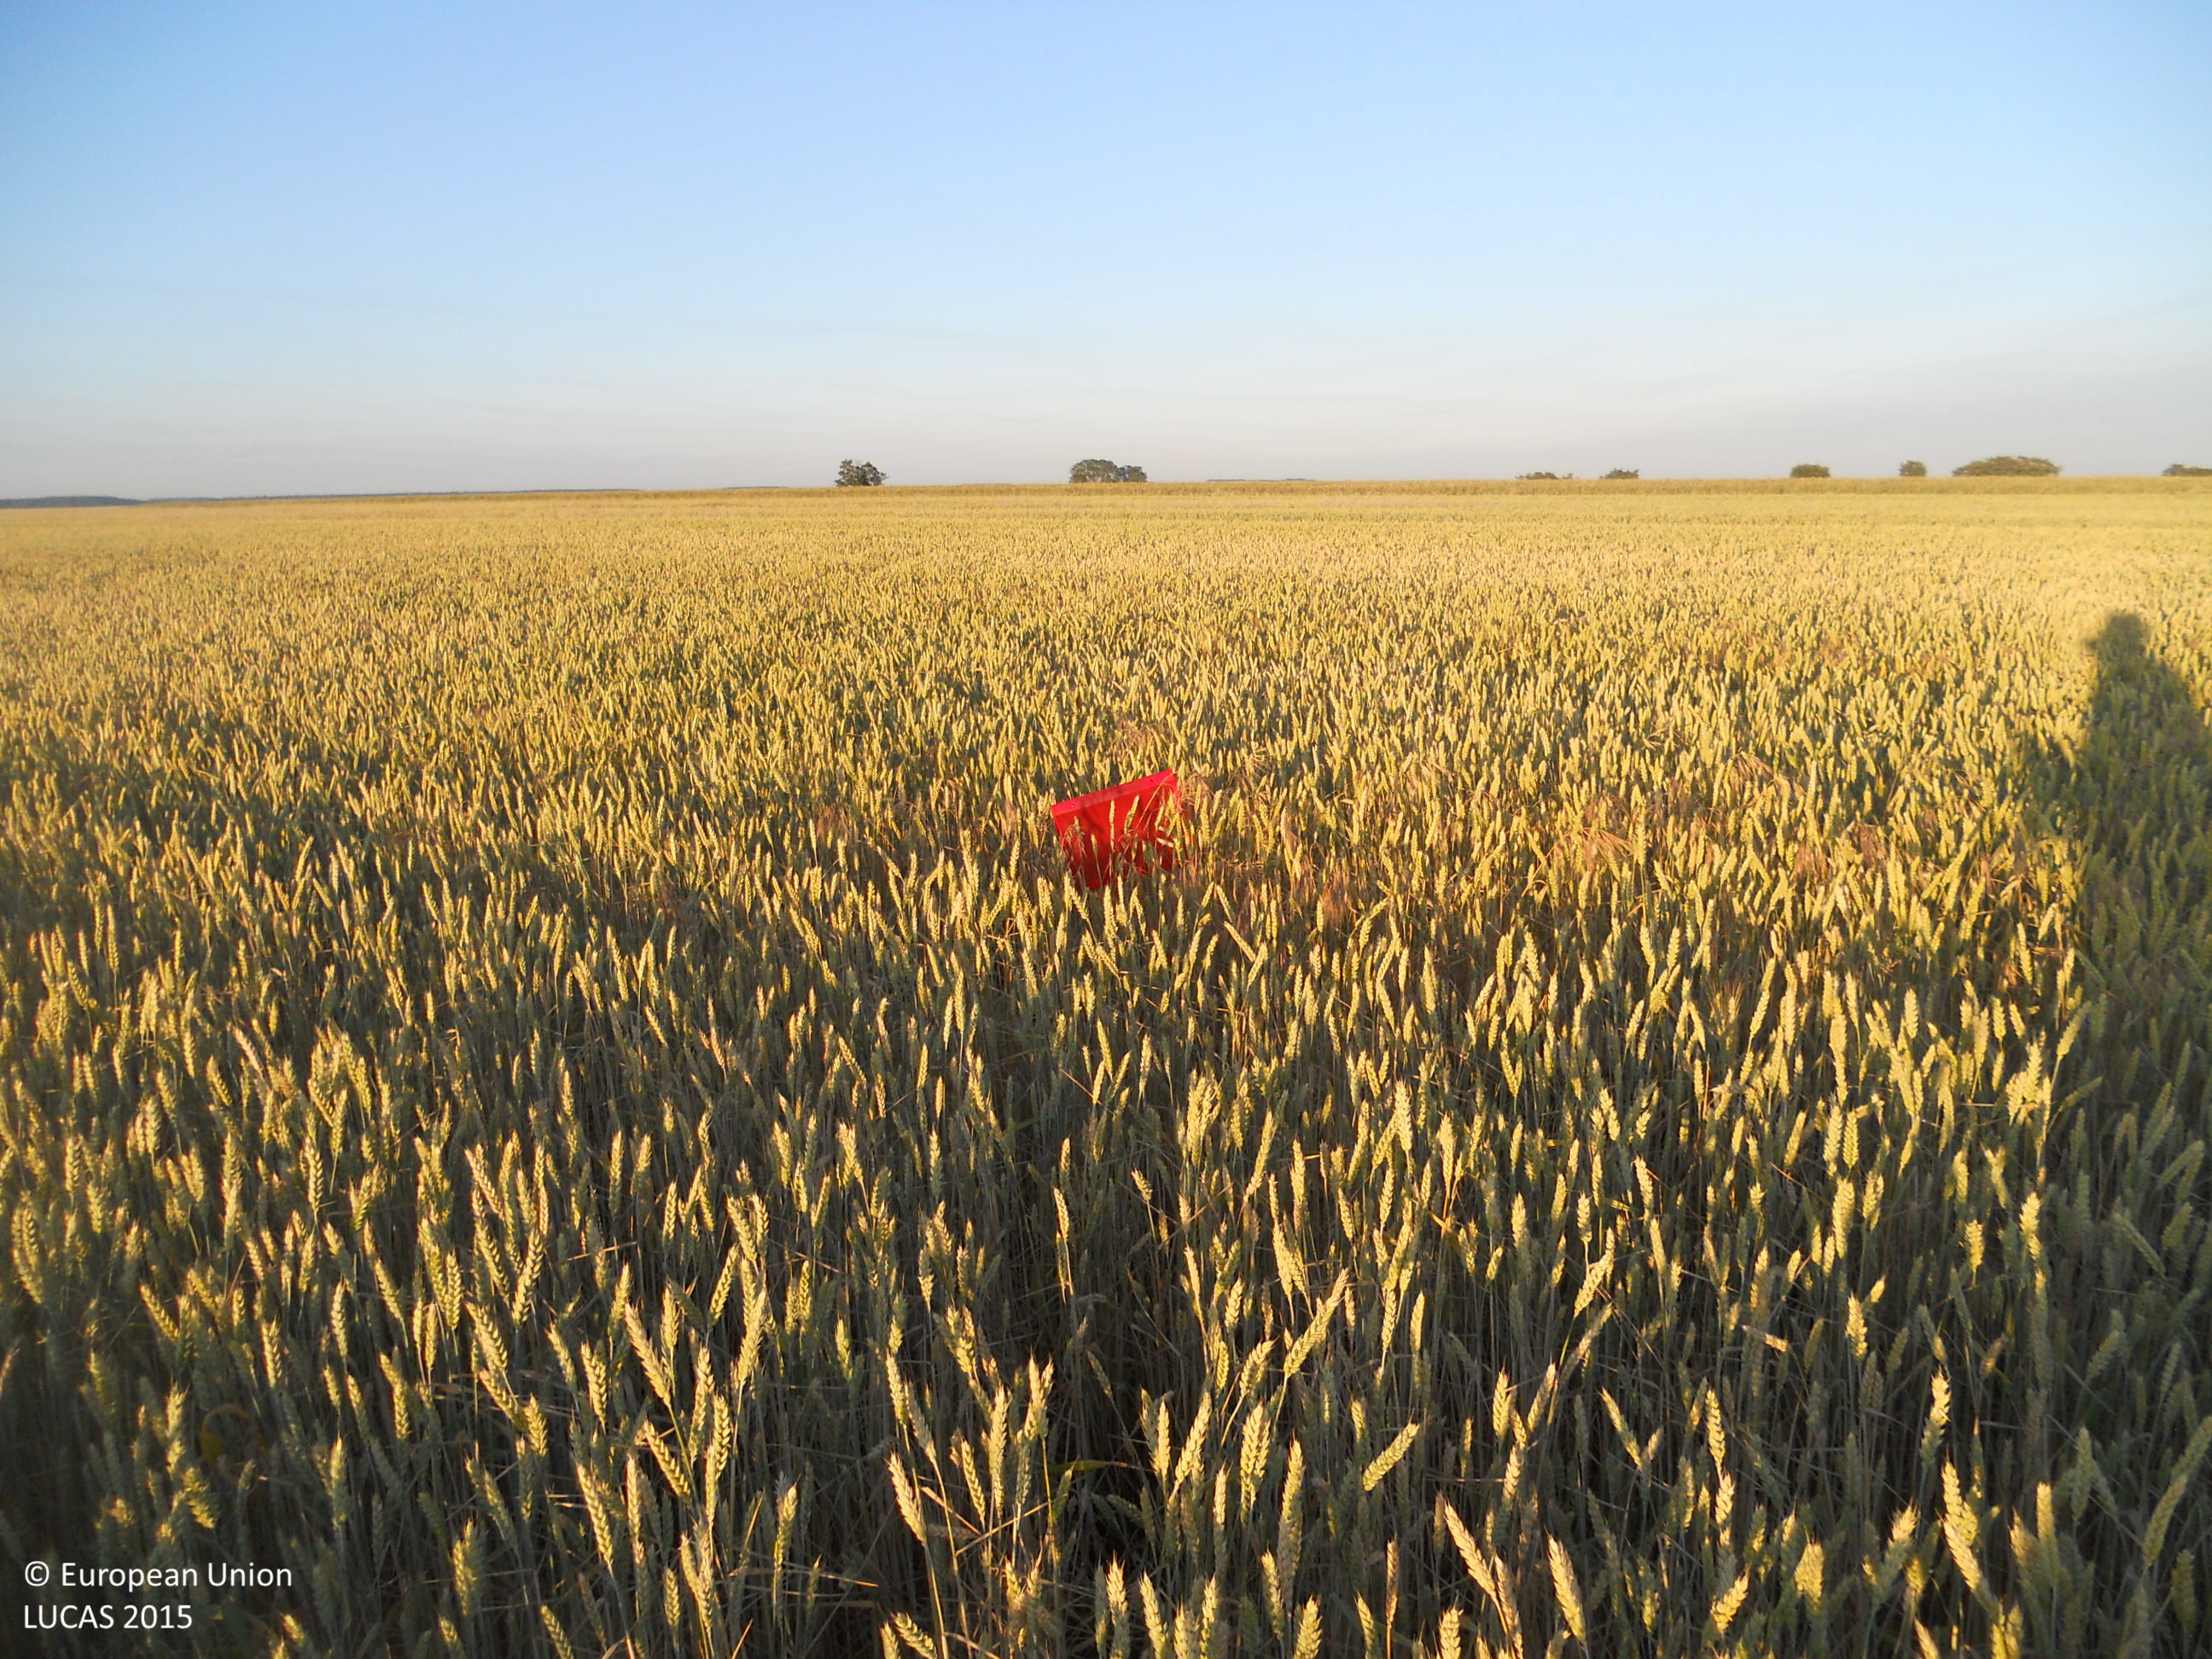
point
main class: Cropland
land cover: Common wheat
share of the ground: > 75 %
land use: Agriculture (excluding fallow land and kitchen gardens)
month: June
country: ES
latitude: 42.4747
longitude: -4.8108
